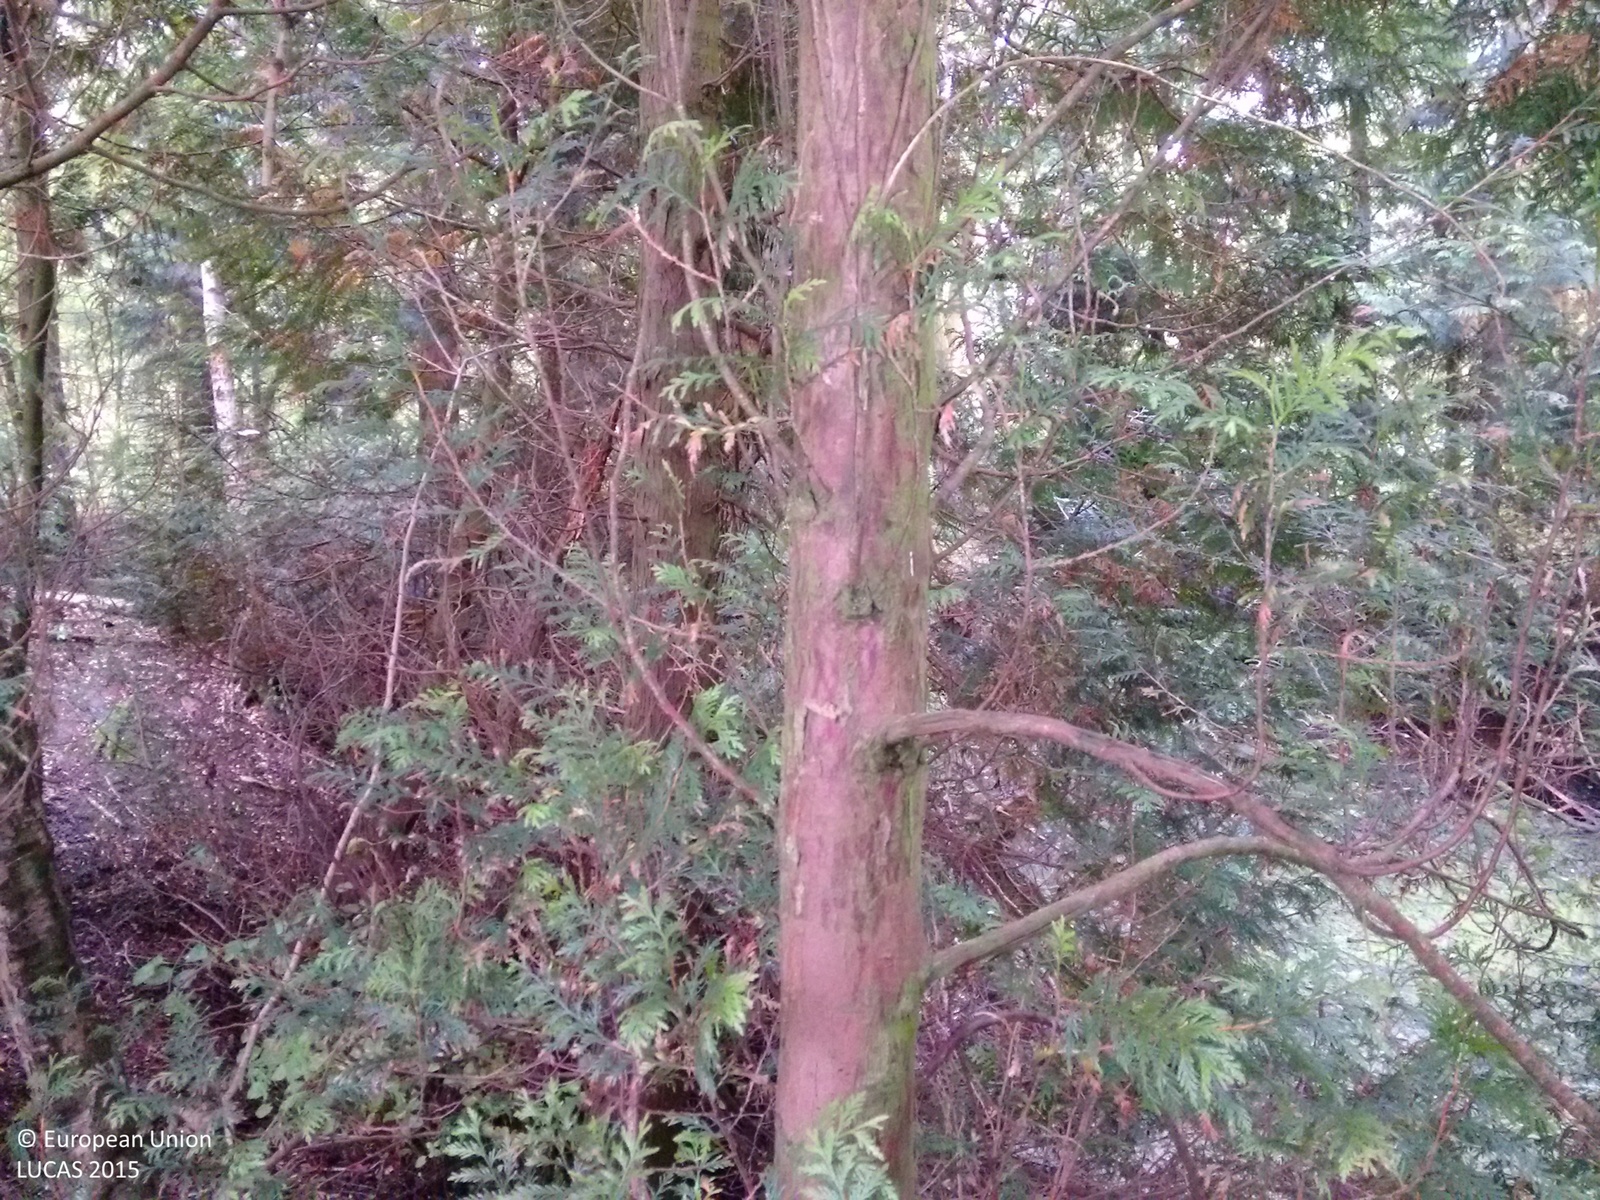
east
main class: Woodland
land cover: Other mixed woodland
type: exotic forest
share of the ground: > 75 %
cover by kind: coniferous forest trees 75 %, broadleaved forest trees 25 %
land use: Semi-natural and natural areas not in use
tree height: > 5 m
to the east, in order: Other mixed woodland; Inland fresh water bodies; Other mixed woodland; Broadleaved woodland; Pine dominated coniferous woodland; Ditches and canals; Pine dominated coniferous woodland; Pine dominated mixed woodland; Grassland without tree/shrub cover
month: September
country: GB
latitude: 52.9723
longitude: -2.9850
